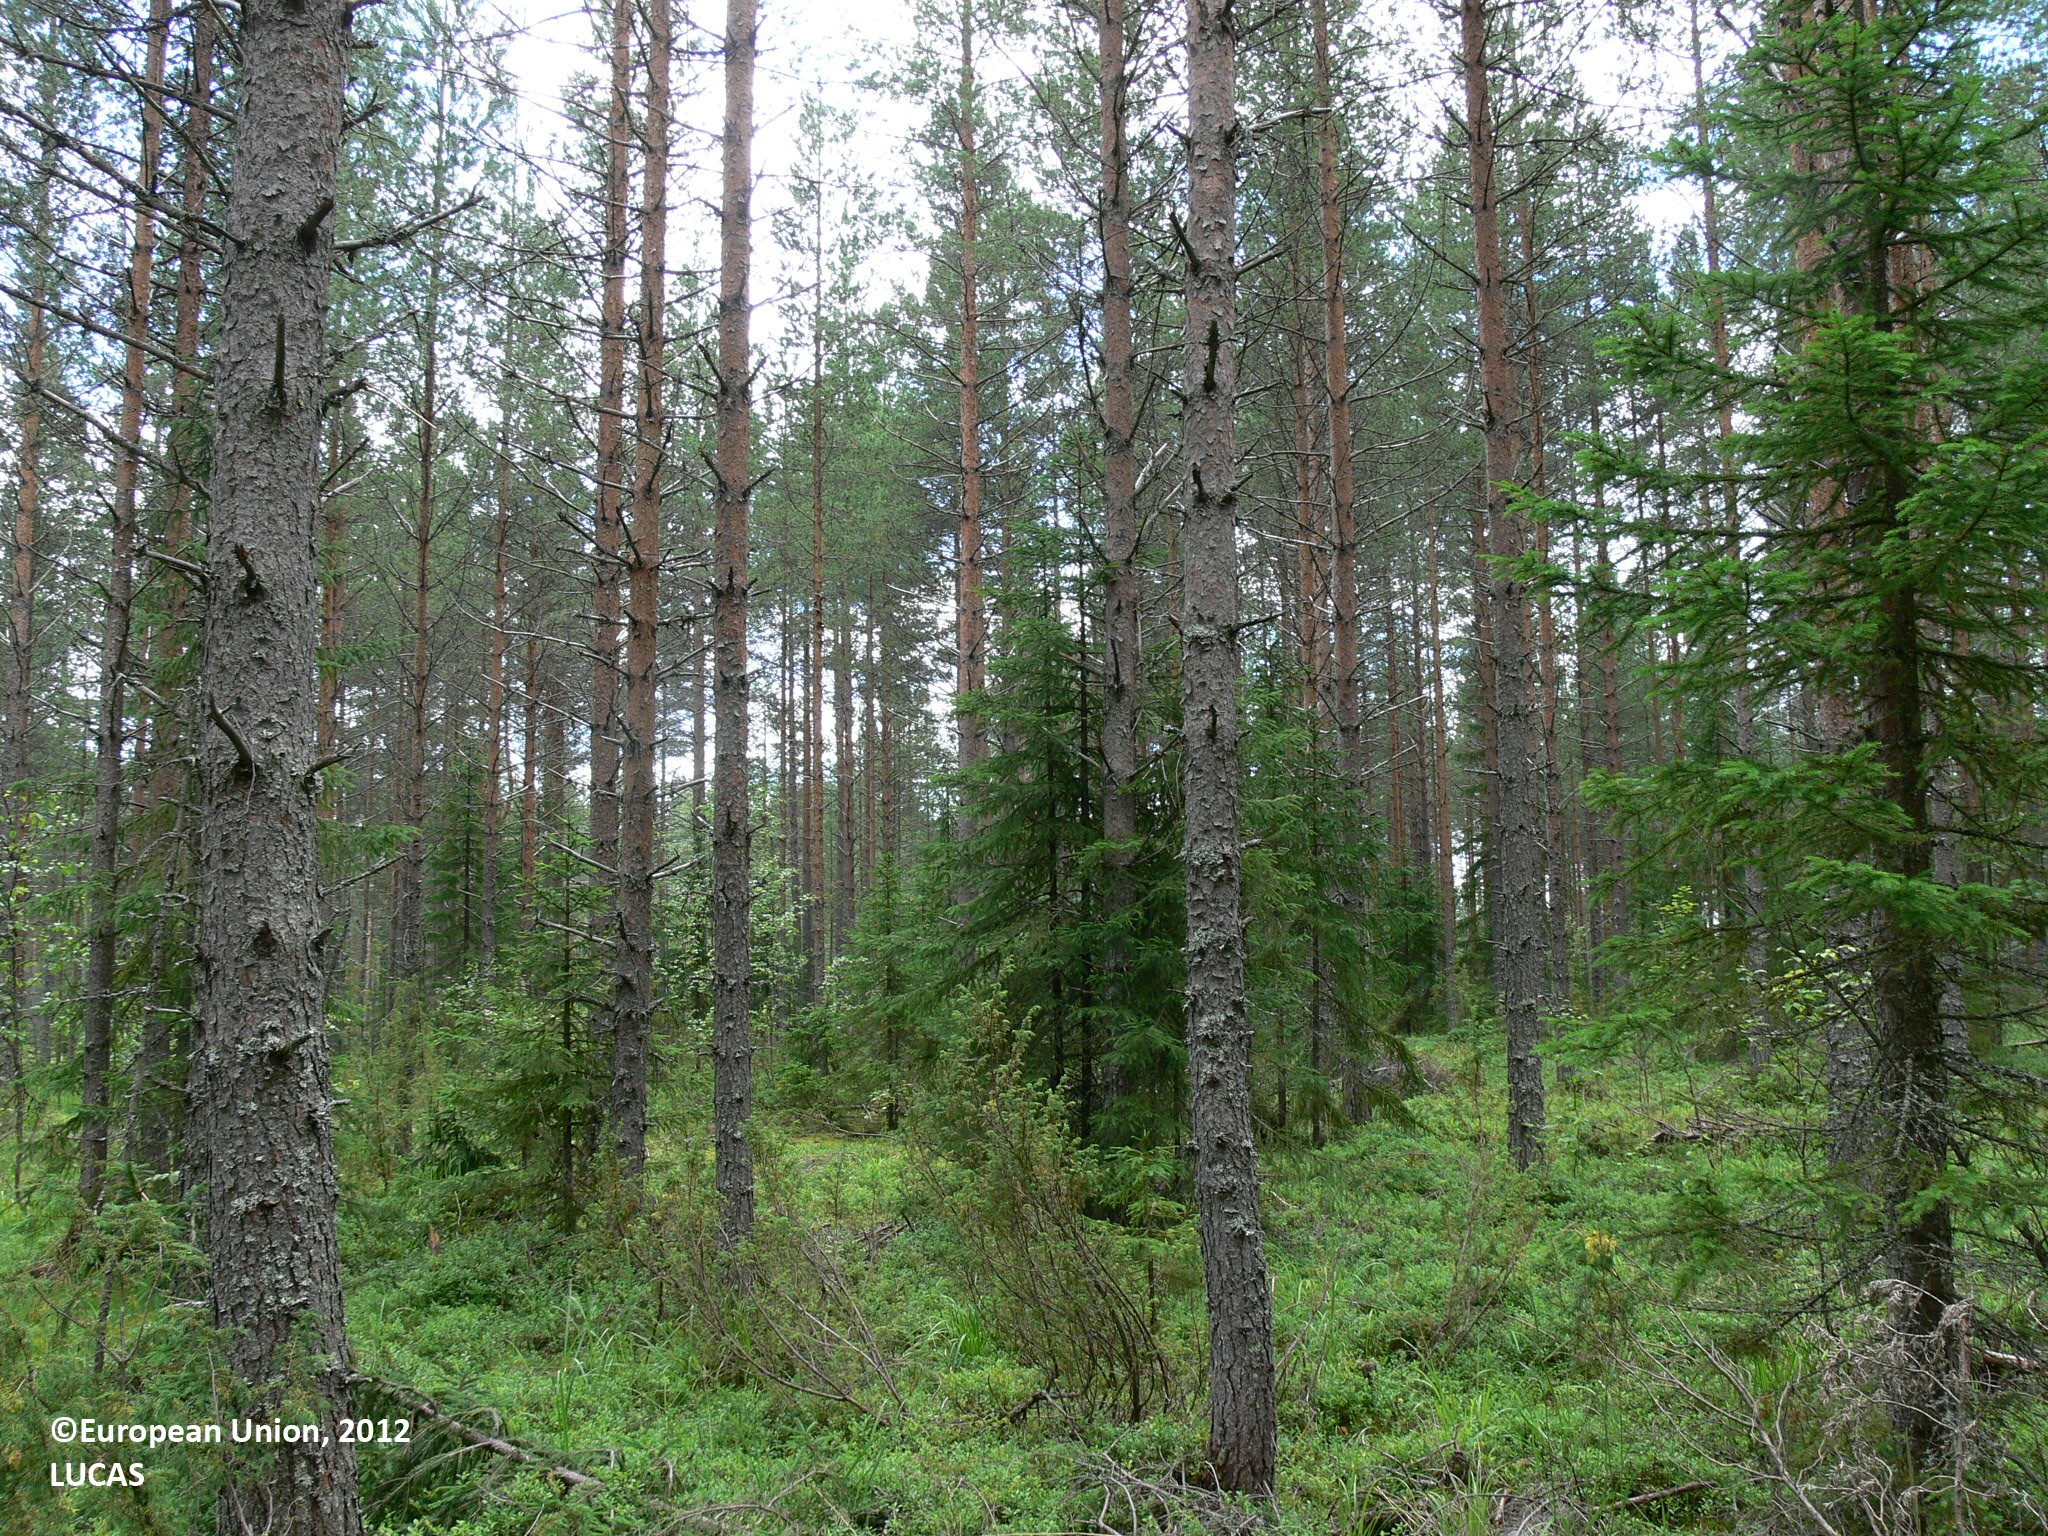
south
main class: Woodland
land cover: Pine dominated coniferous woodland
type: boreal forest
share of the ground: > 75 %
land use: Forestry
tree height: > 5 m
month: July
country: FI
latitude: 63.0282
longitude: 29.4196
